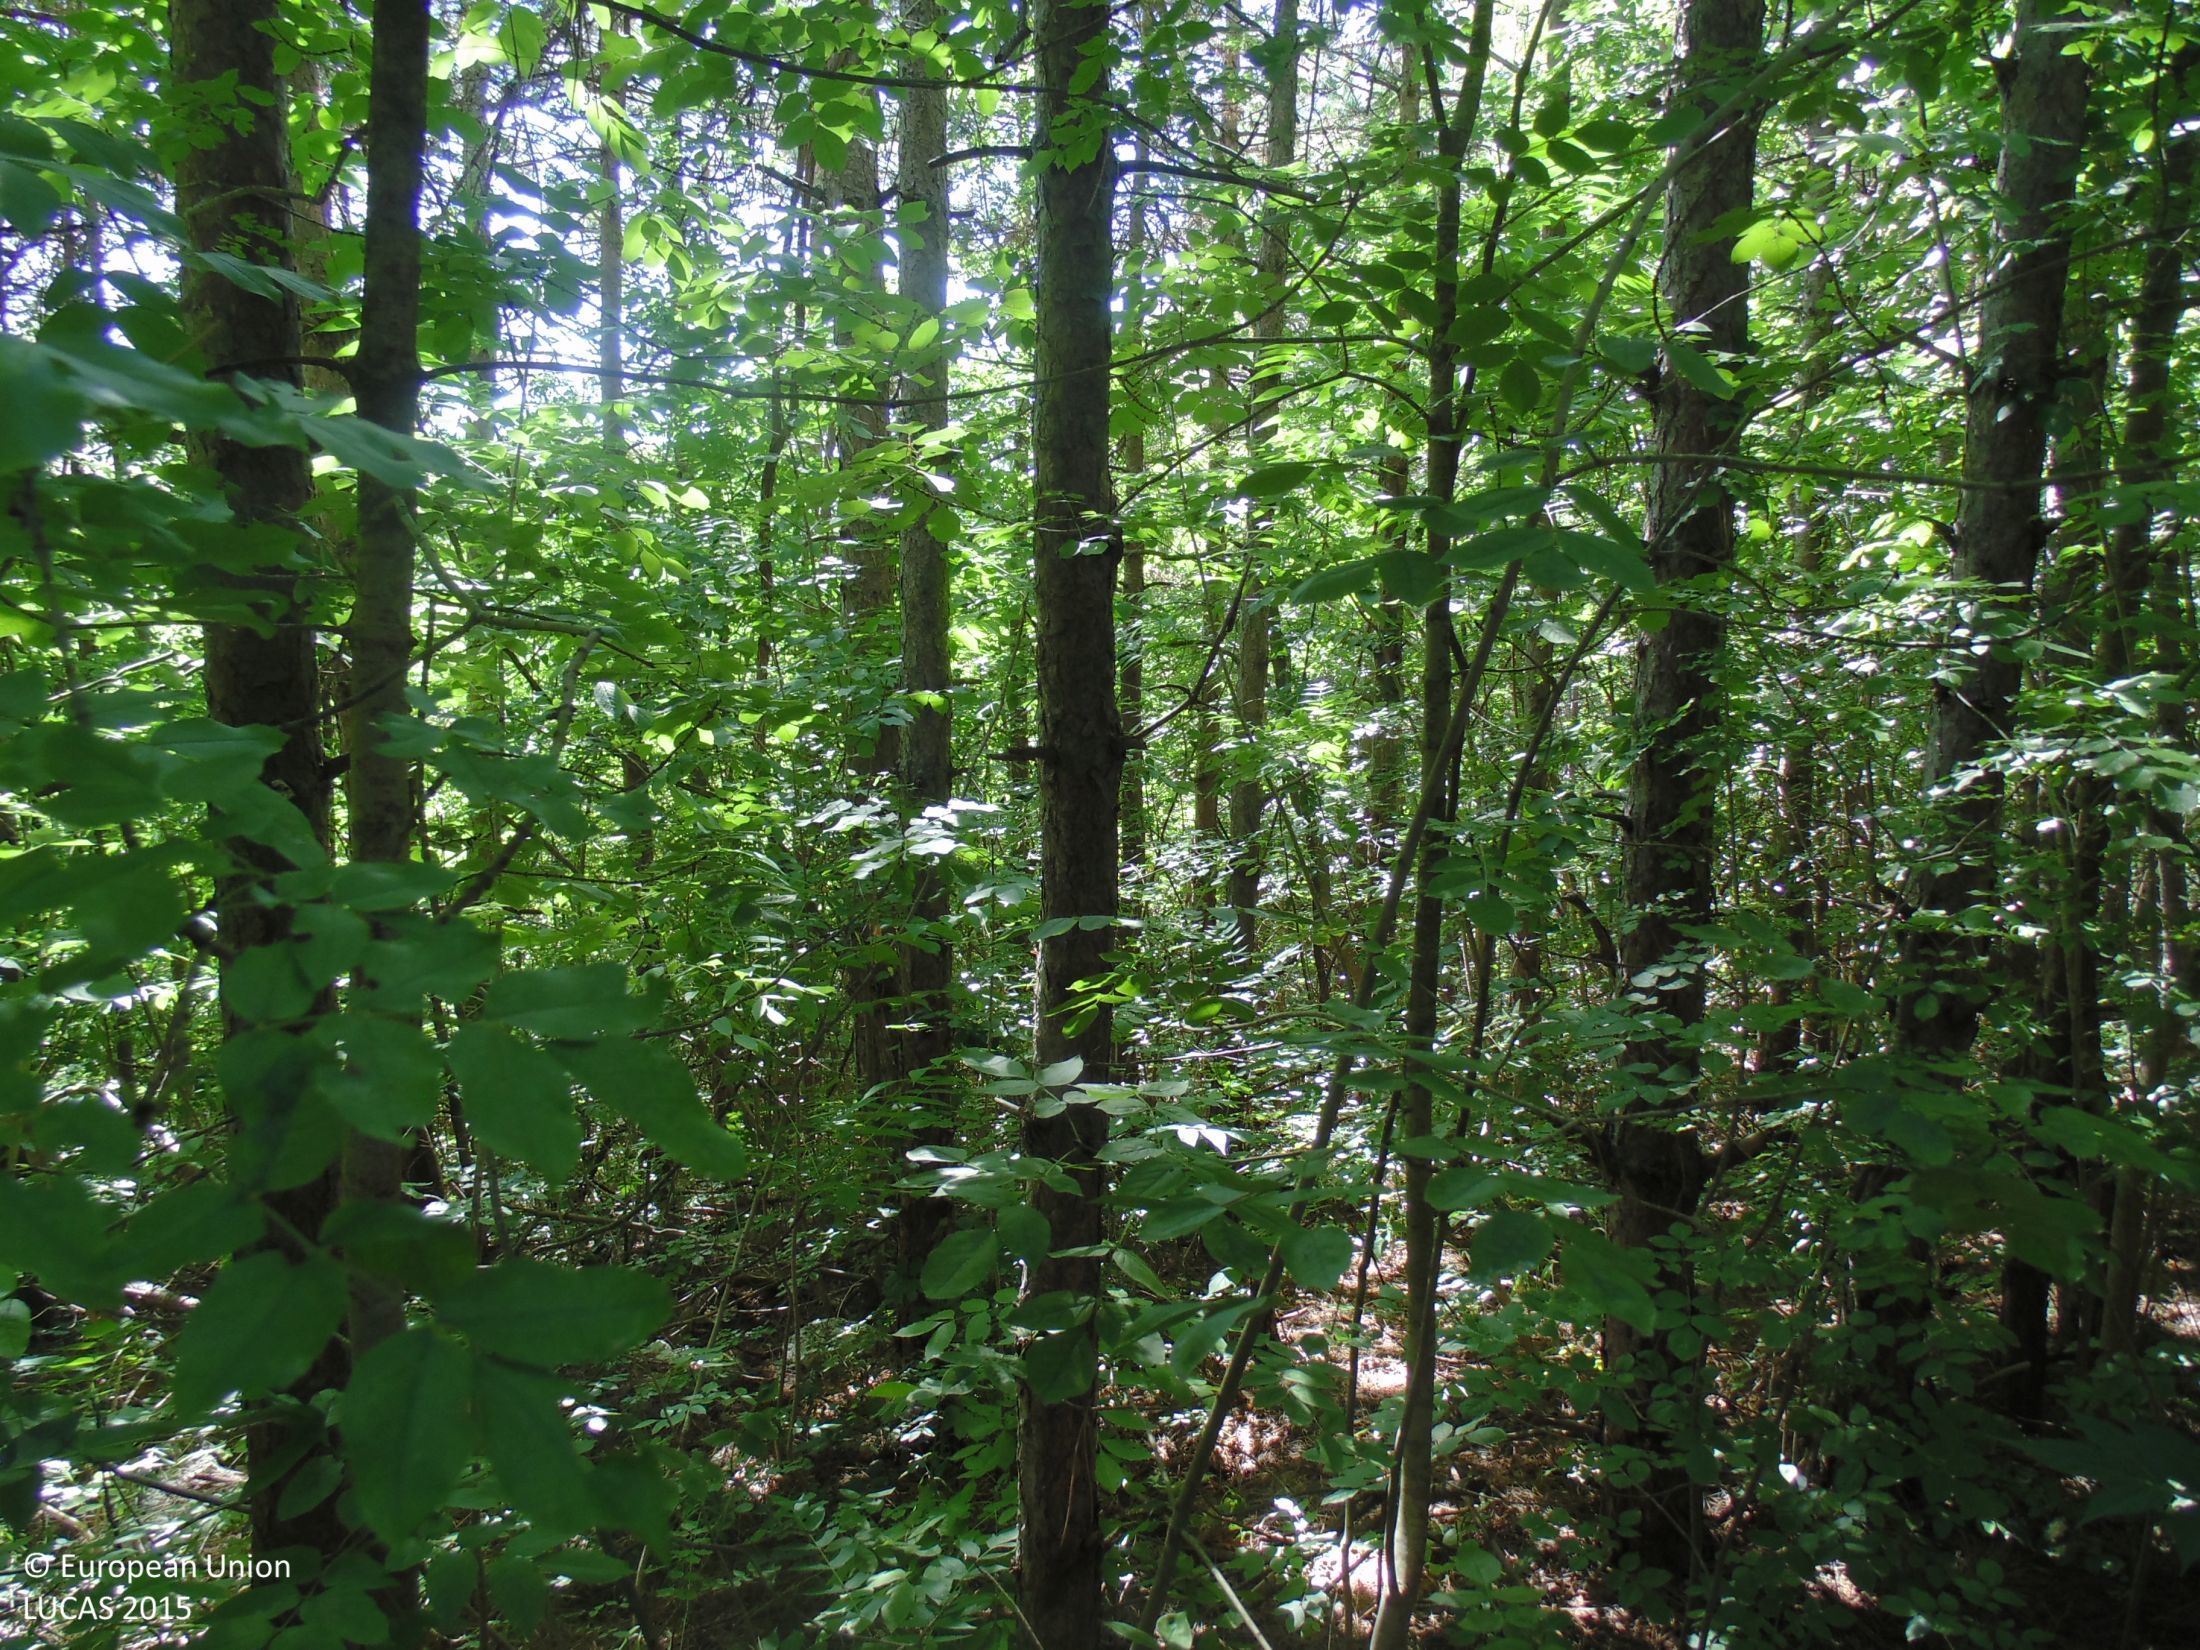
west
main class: Woodland
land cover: Pine dominated coniferous woodland
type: hemiboreal forest and nemoral coniferous forest and mixed broadleaved-coniferous forest
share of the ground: > 75 %
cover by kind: coniferous forest trees 85 %, shrubs 10 %, herbaceous plants 5 %
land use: Forestry
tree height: > 5 m
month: July
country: BG
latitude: 43.4173
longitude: 28.1437
